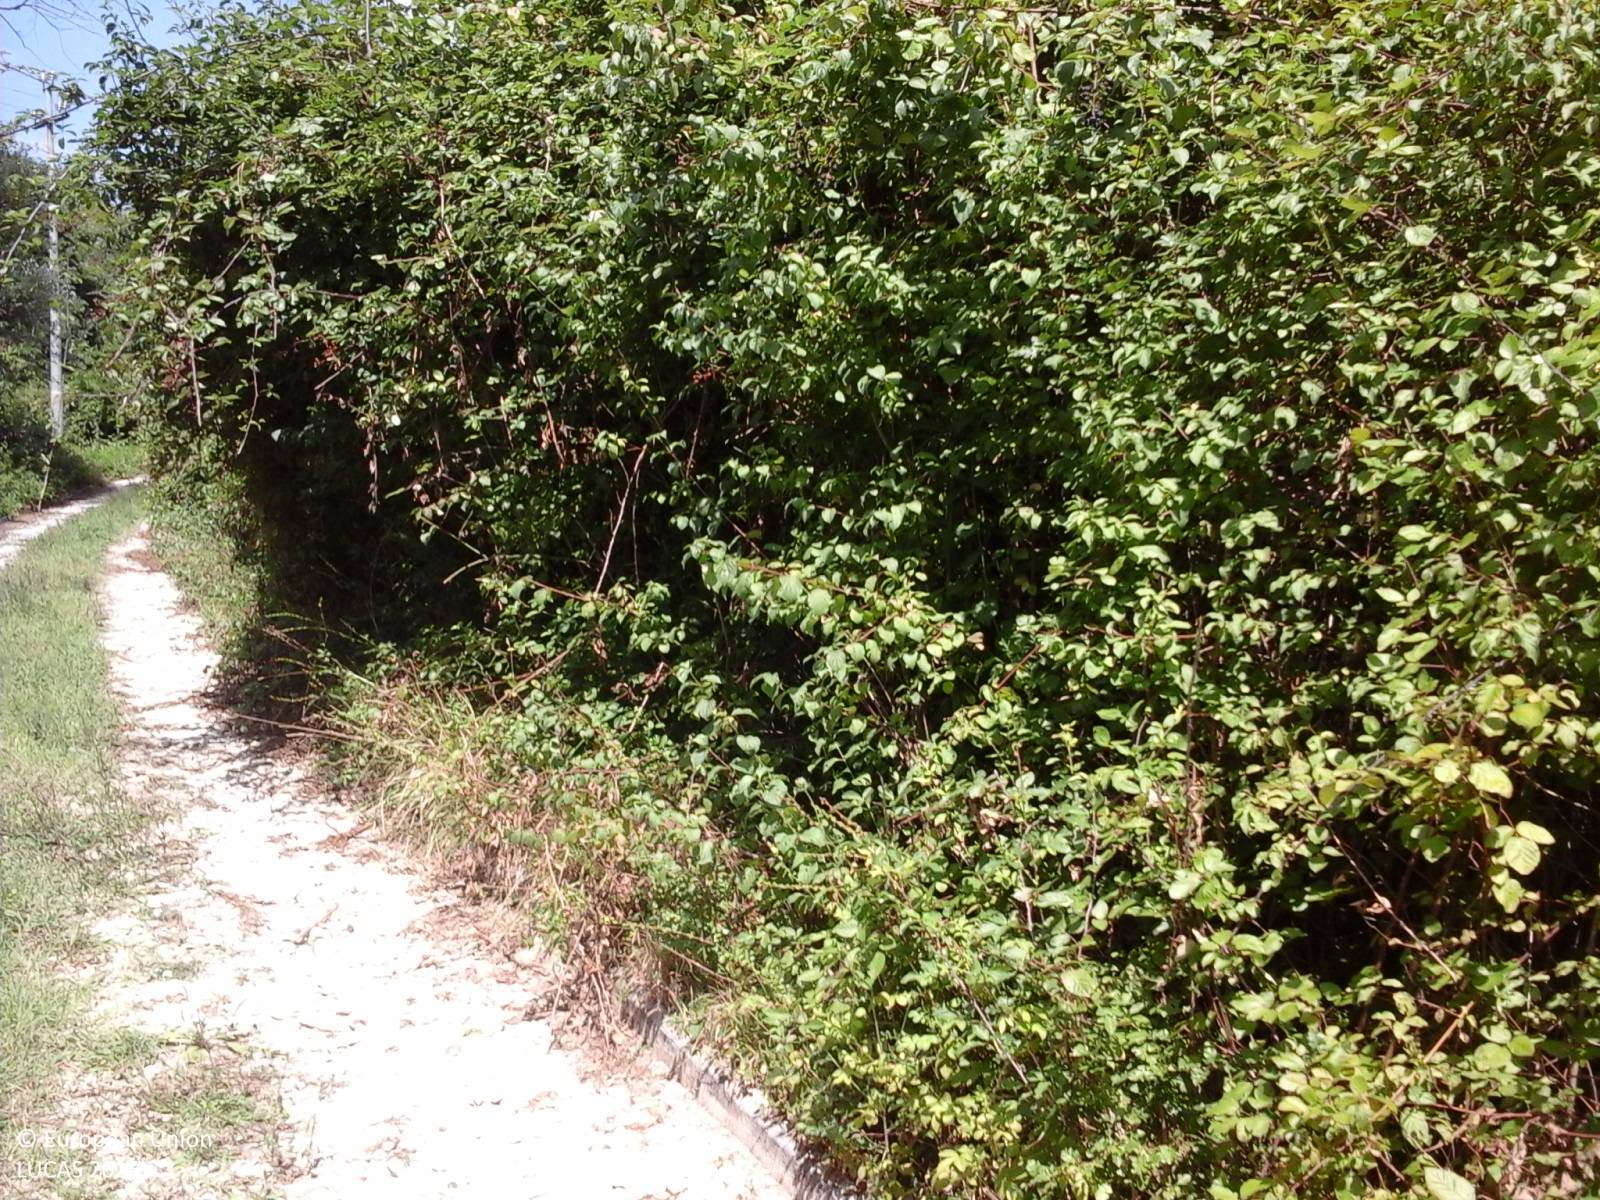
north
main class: Woodland
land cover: Broadleaved woodland
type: thermophilous deciduous forest
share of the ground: > 75 %
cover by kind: broadleaved forest trees 70 %, shrubs 30 %
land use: Semi-natural and natural areas not in use
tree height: > 5 m
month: July
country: IT
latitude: 42.2232
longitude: 12.5957
